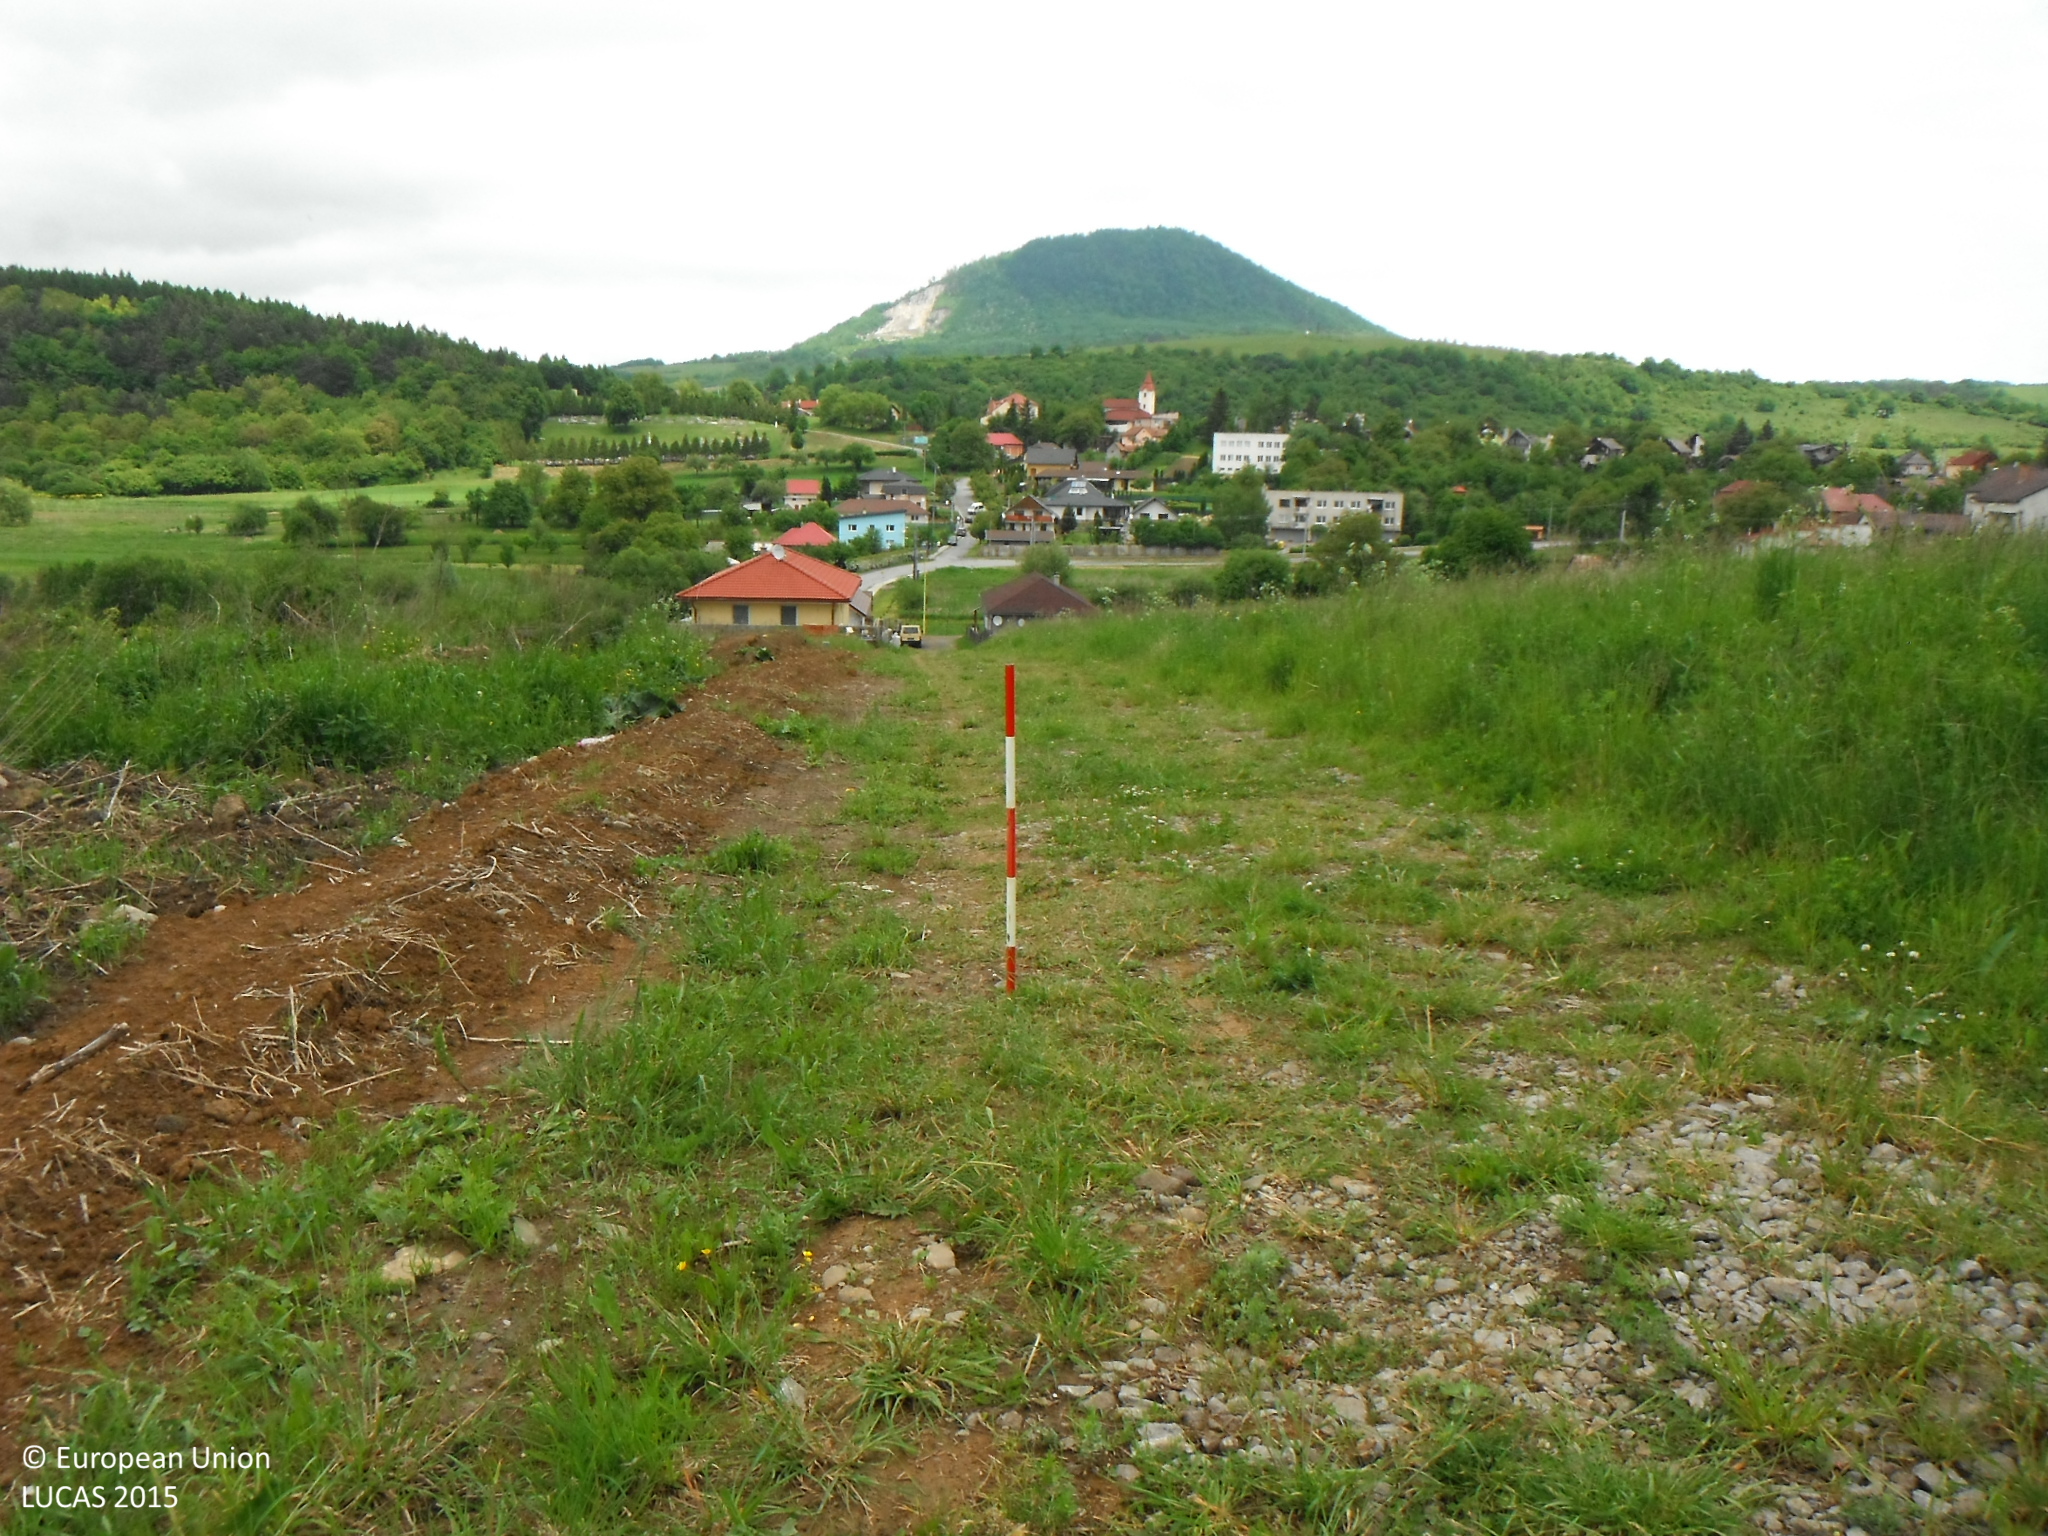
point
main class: Artificial land
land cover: Non built-up linear features
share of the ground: > 75 %
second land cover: Spontaneously vegetated surfaces
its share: 25 - 50 %
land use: Road transport
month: May
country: SK
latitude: 49.0675
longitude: 21.1999
